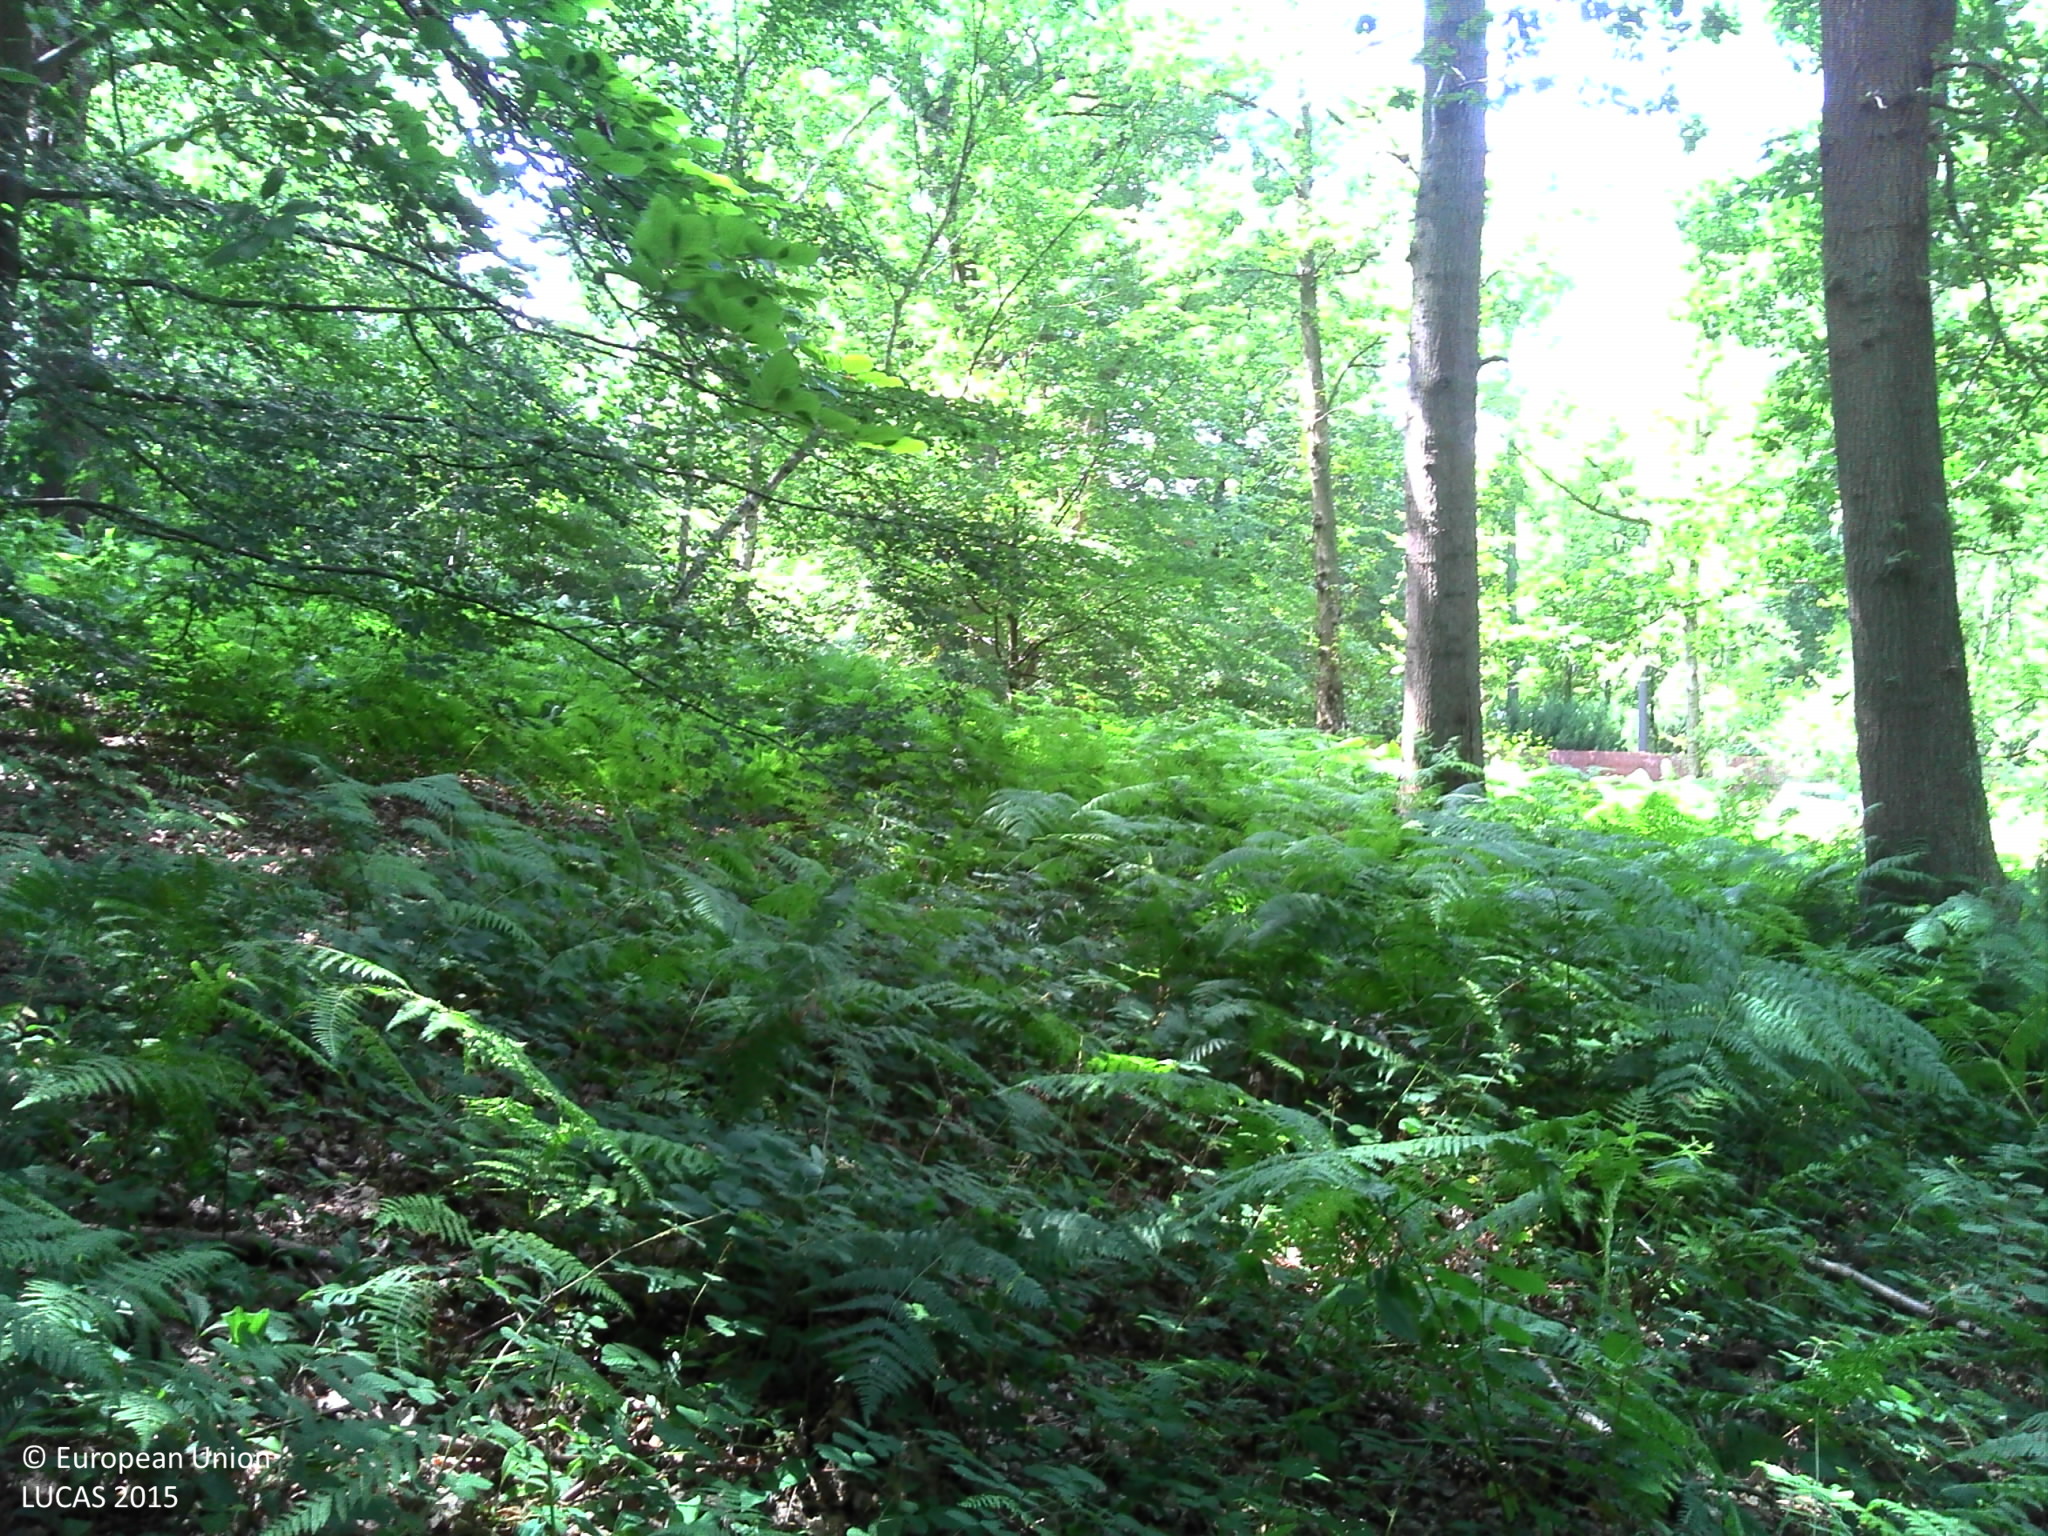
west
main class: Woodland
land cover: Broadleaved woodland
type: acidophilous oak and oak-birch forest
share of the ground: > 75 %
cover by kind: broadleaved forest trees 90 %, herbaceous plants 10 %
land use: Forestry
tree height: > 5 m
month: July
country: FR
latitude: 49.1219
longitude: 2.4656
